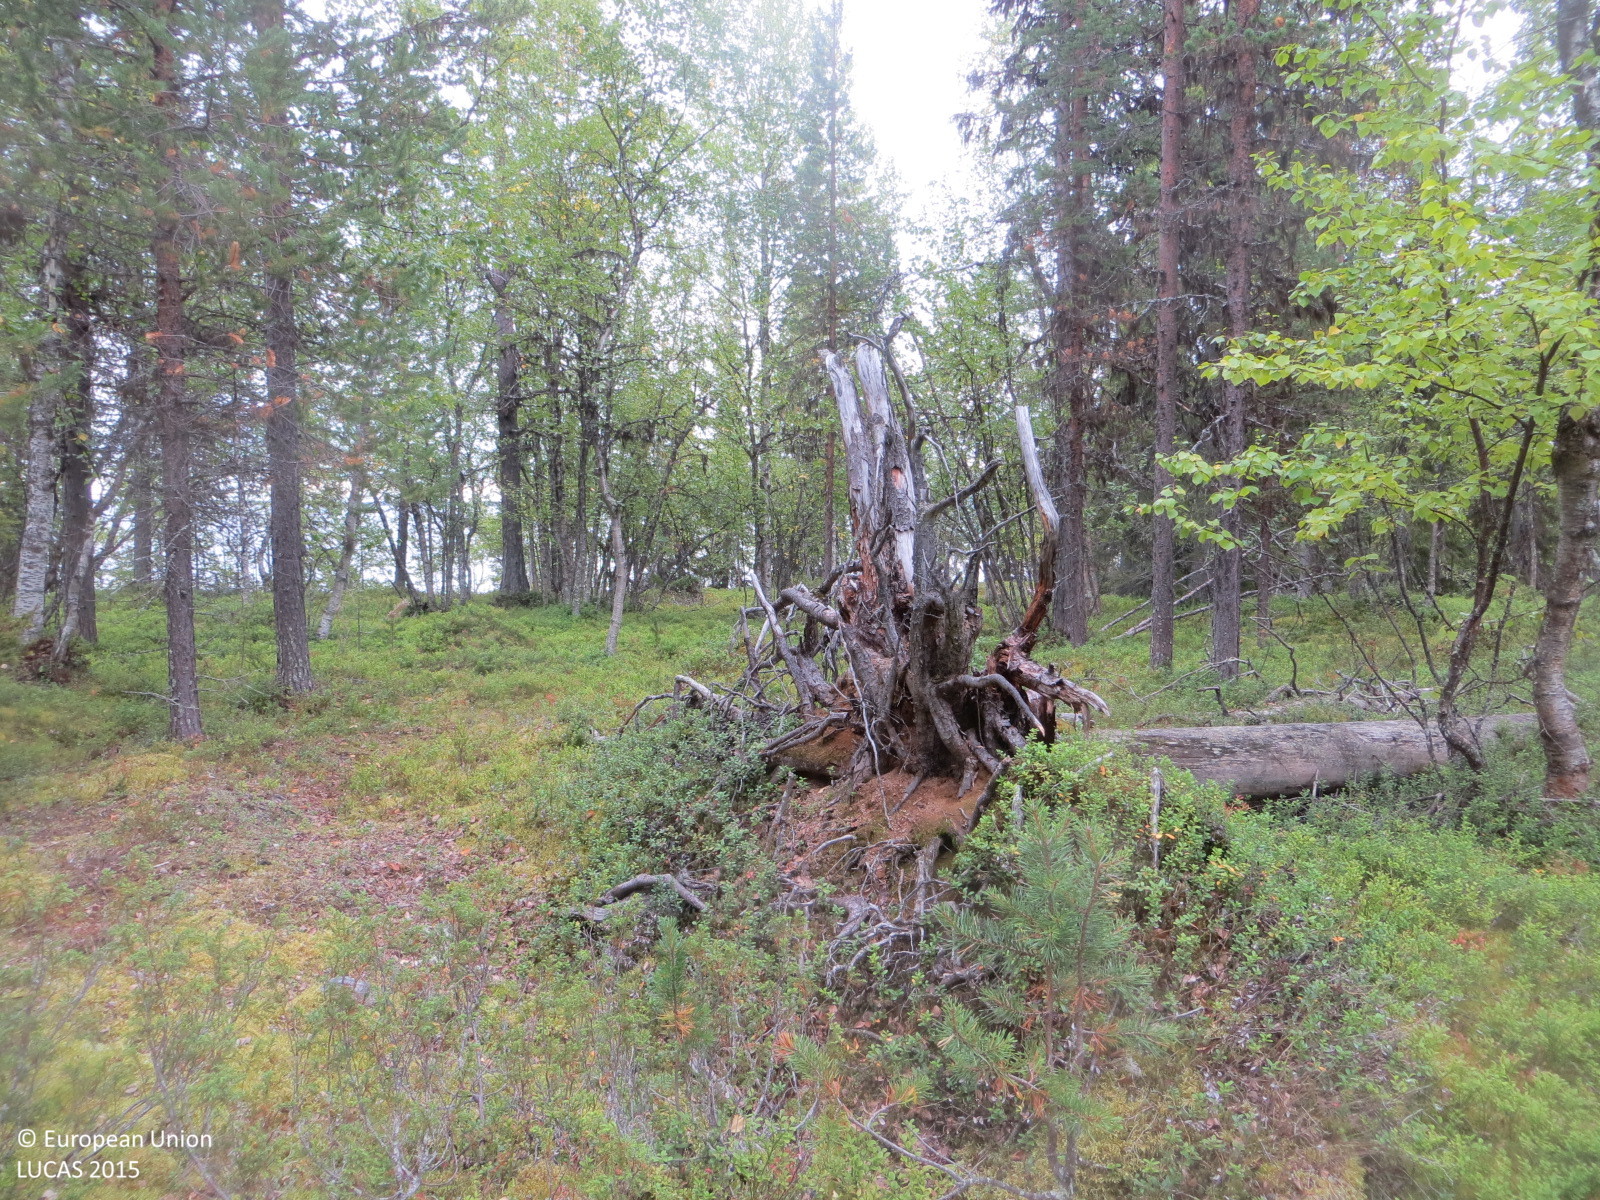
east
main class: Woodland
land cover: Other mixed woodland
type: boreal forest
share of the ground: 50 - 75 %
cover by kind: shrubs 50 %, broadleaved forest trees 30 %, coniferous forest trees 20 %
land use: Semi-natural and natural areas not in use
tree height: > 5 m
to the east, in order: Other mixed woodland; Tracks; Other mixed woodland; Inland fresh water bodies
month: September
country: FI
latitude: 68.0216
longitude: 24.1683
